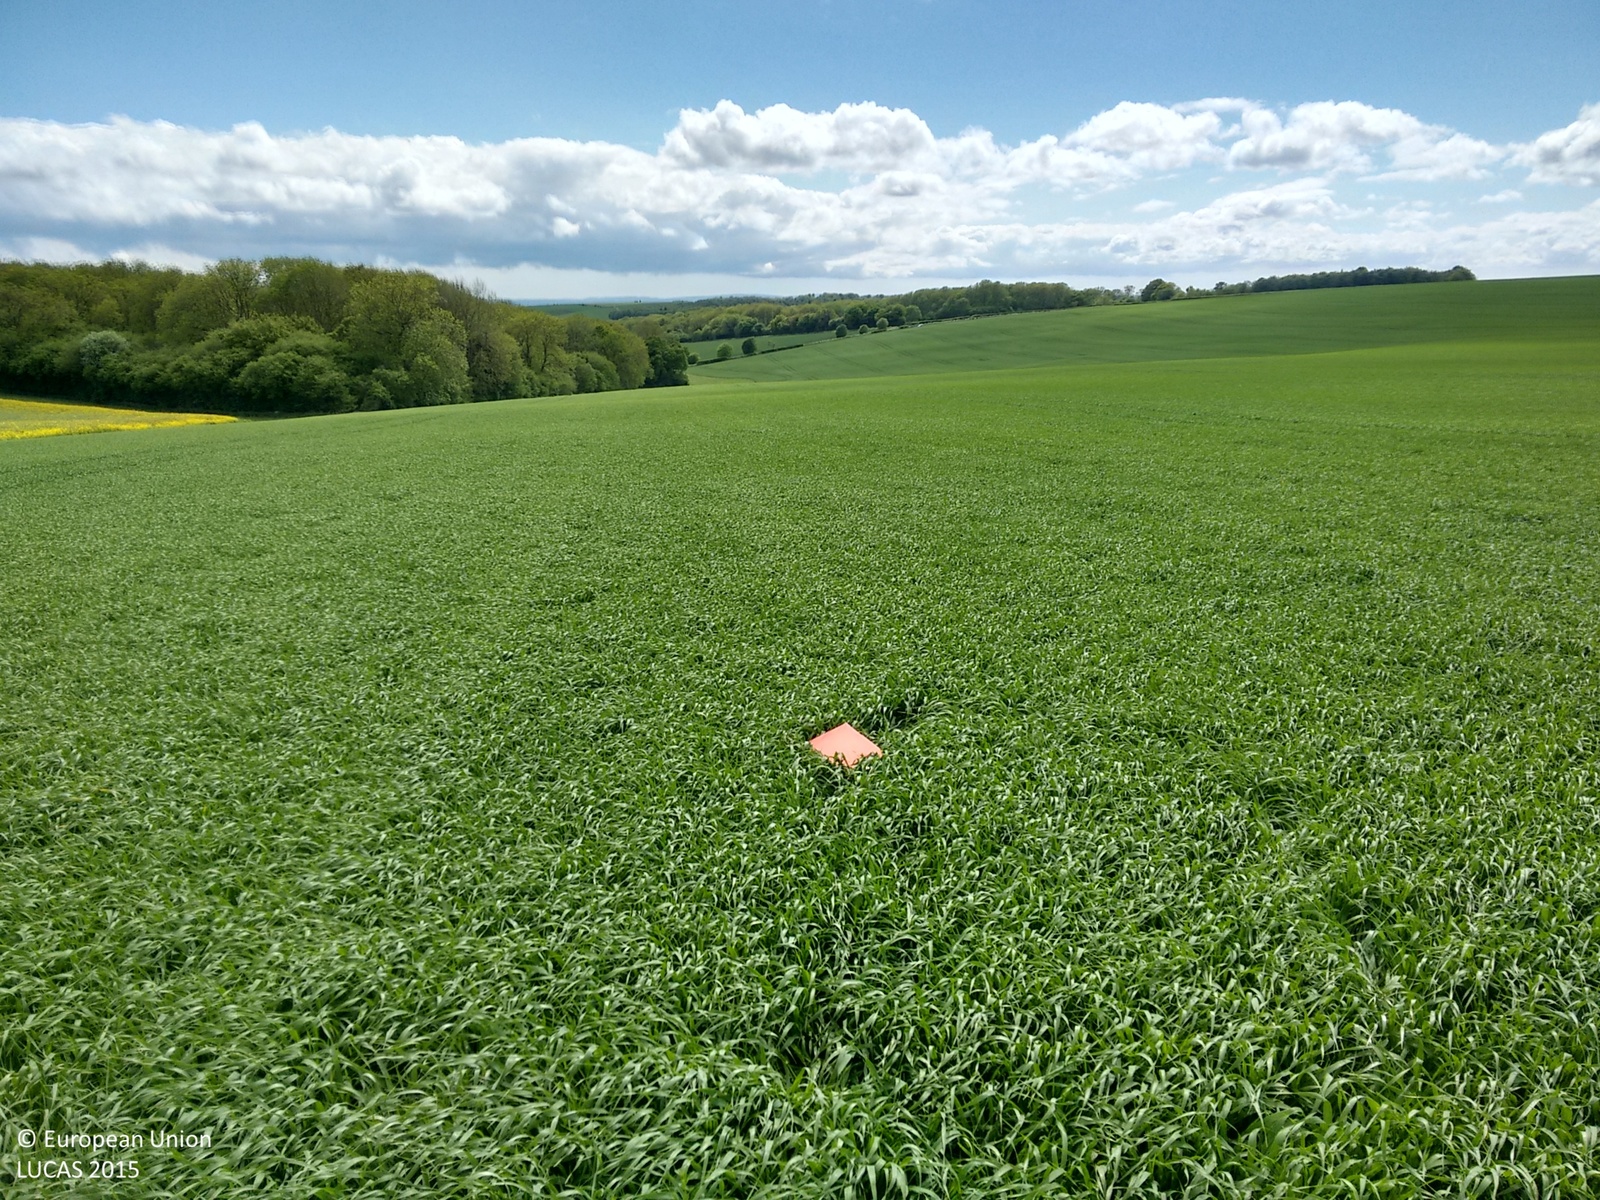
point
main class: Cropland
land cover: Barley
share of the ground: > 75 %
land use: Agriculture (excluding fallow land and kitchen gardens)
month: May
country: GB
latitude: 50.9674
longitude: -1.0812
